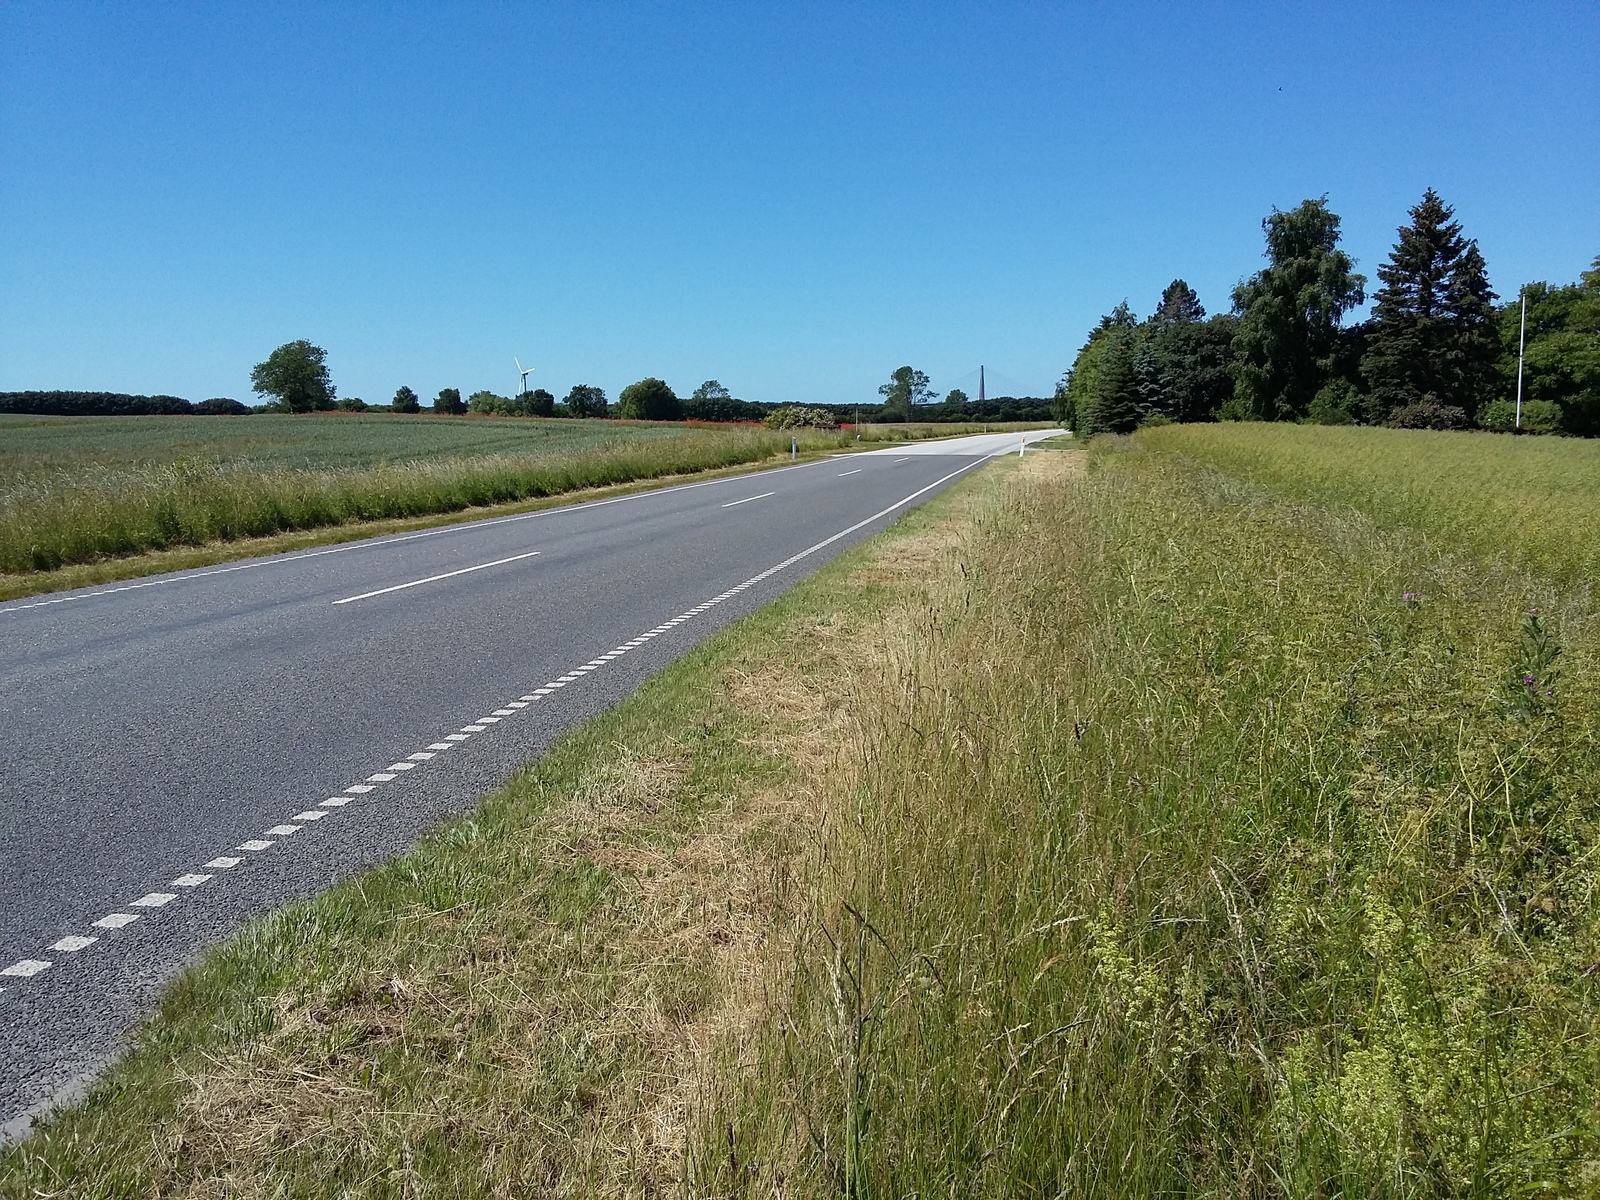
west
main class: Cropland
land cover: Rape and turnip rape
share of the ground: > 75 %
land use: Agriculture (excluding fallow land and kitchen gardens)
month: July
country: DK
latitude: 54.9314
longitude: 12.0119
